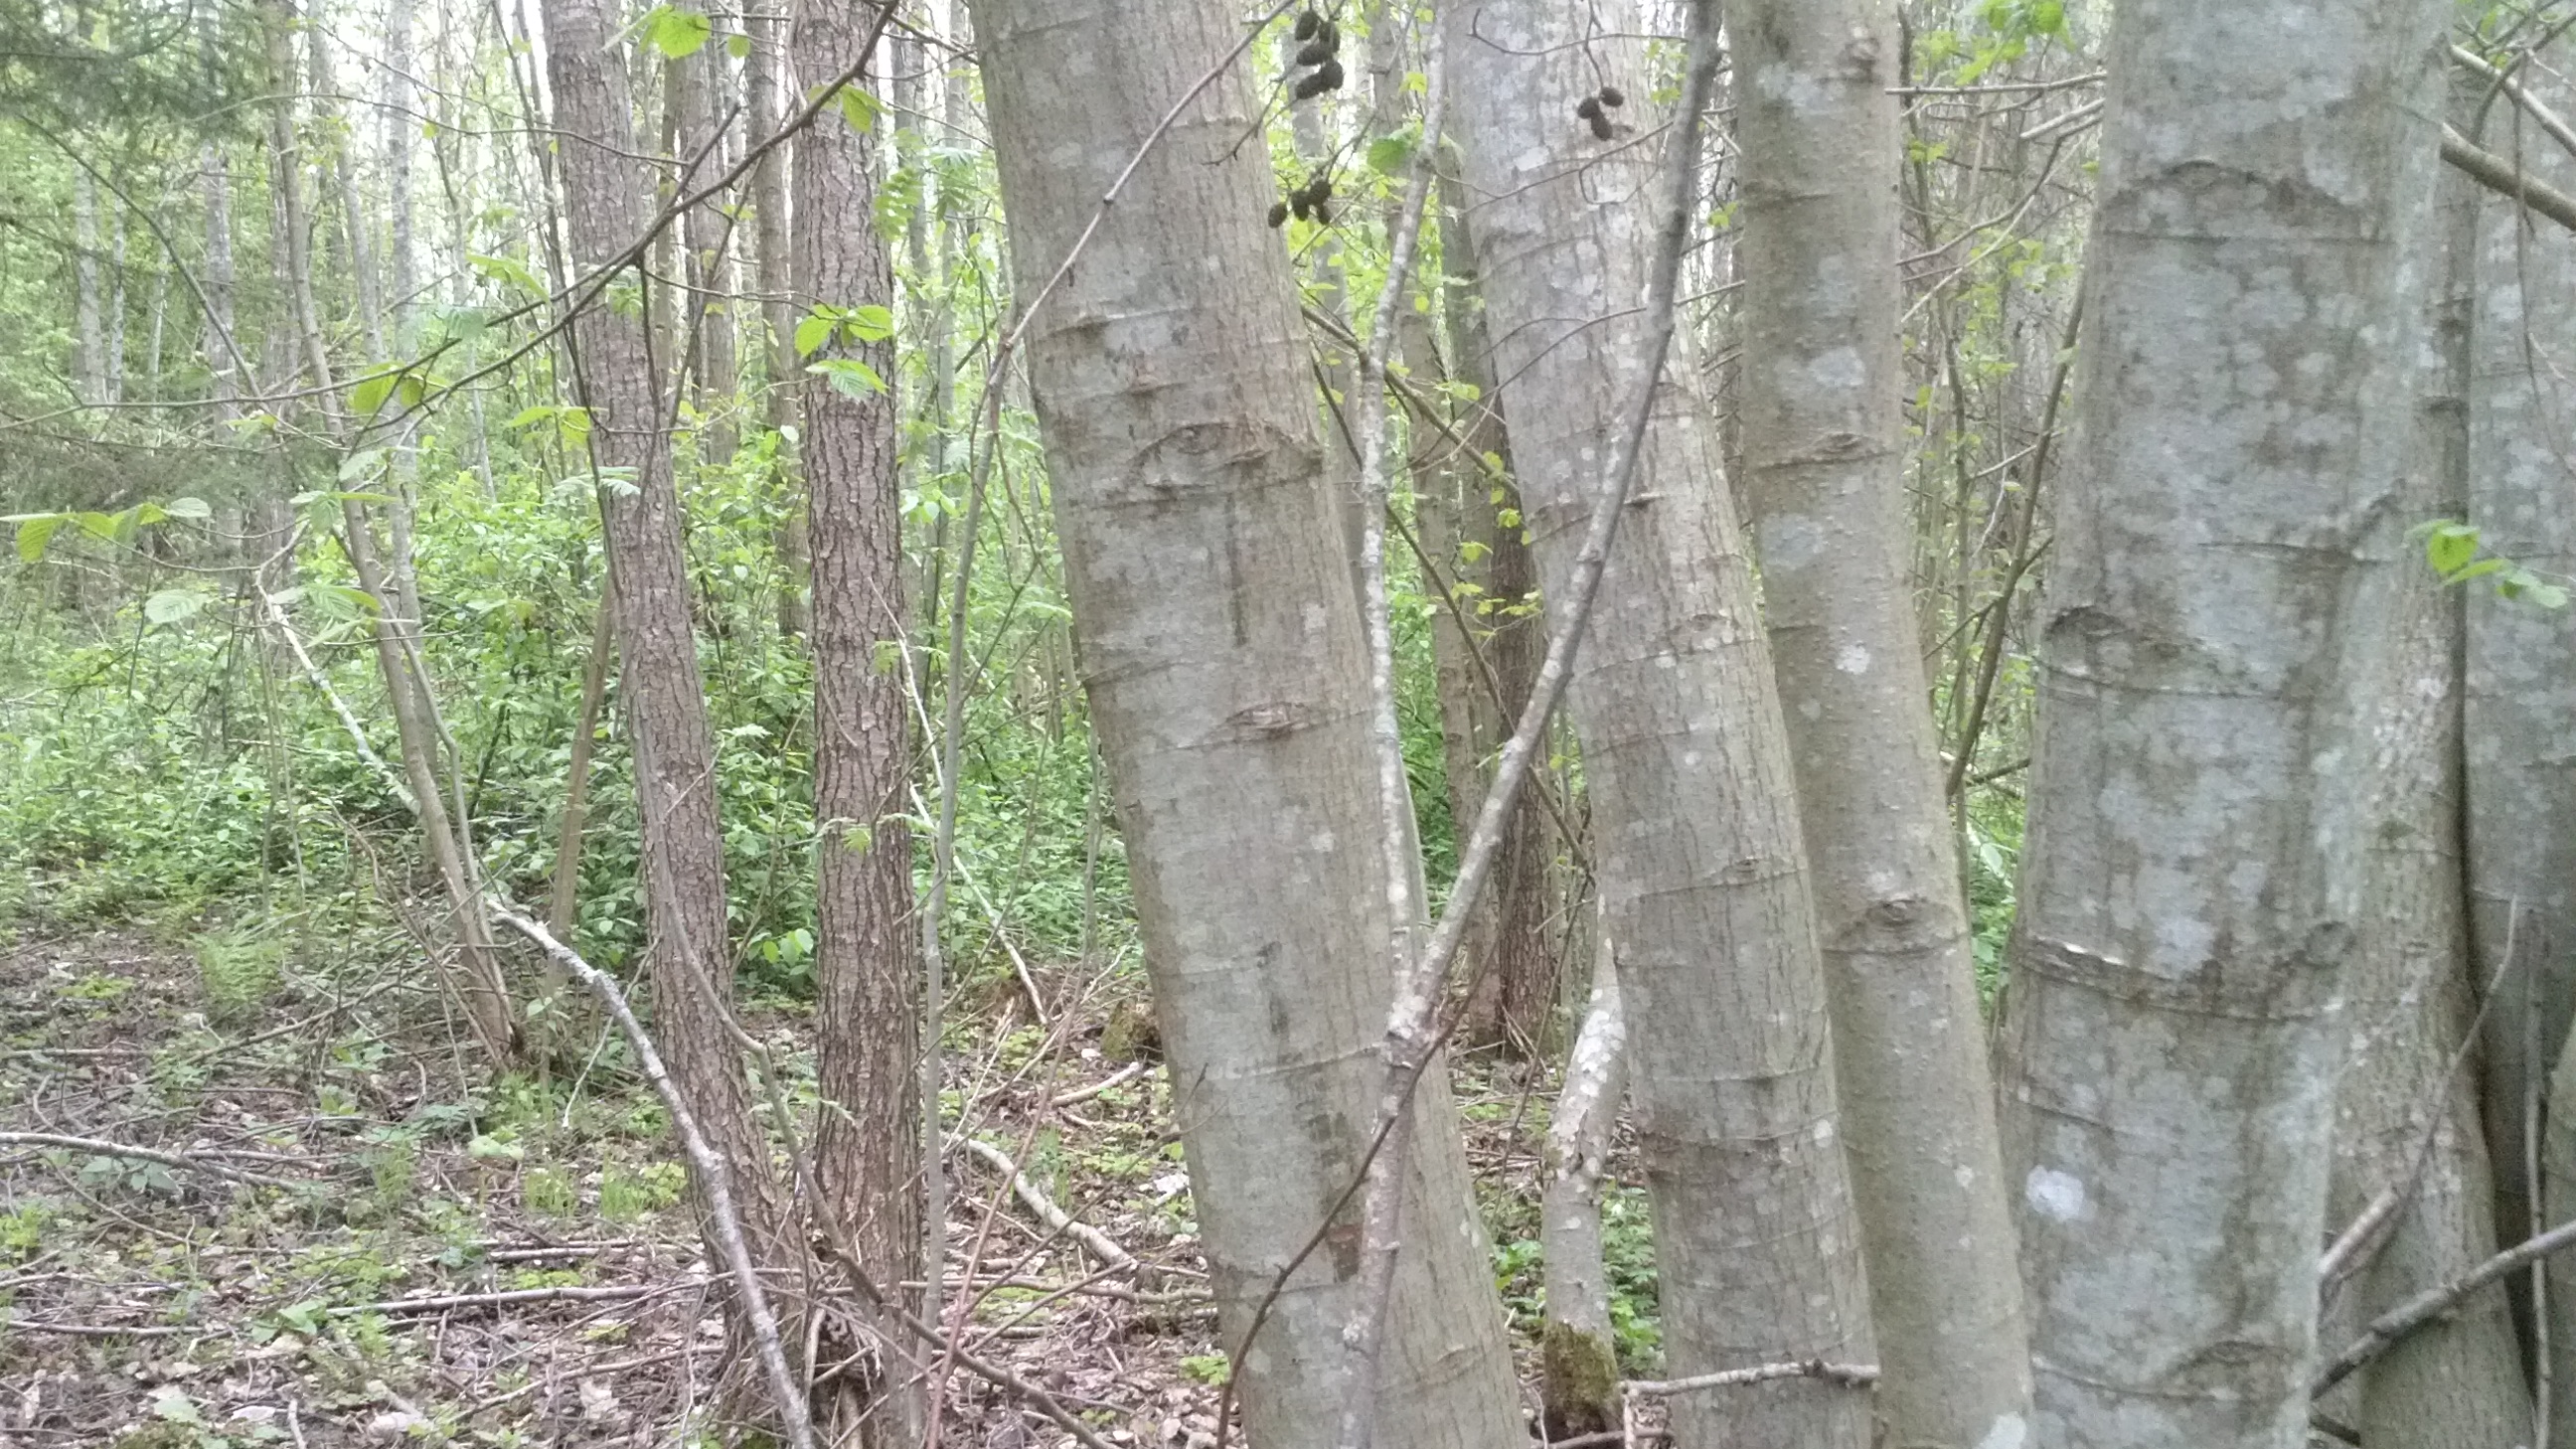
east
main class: Woodland
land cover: Broadleaved woodland
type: non-riverine alder, birch or aspen forest
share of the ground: > 75 %
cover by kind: broadleaved forest trees 90 %, coniferous forest trees 10 %
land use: Forestry
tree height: > 5 m
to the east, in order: Broadleaved woodland; Tracks; Broadleaved woodland
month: May
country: LV
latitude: 55.9838
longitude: 27.1106
